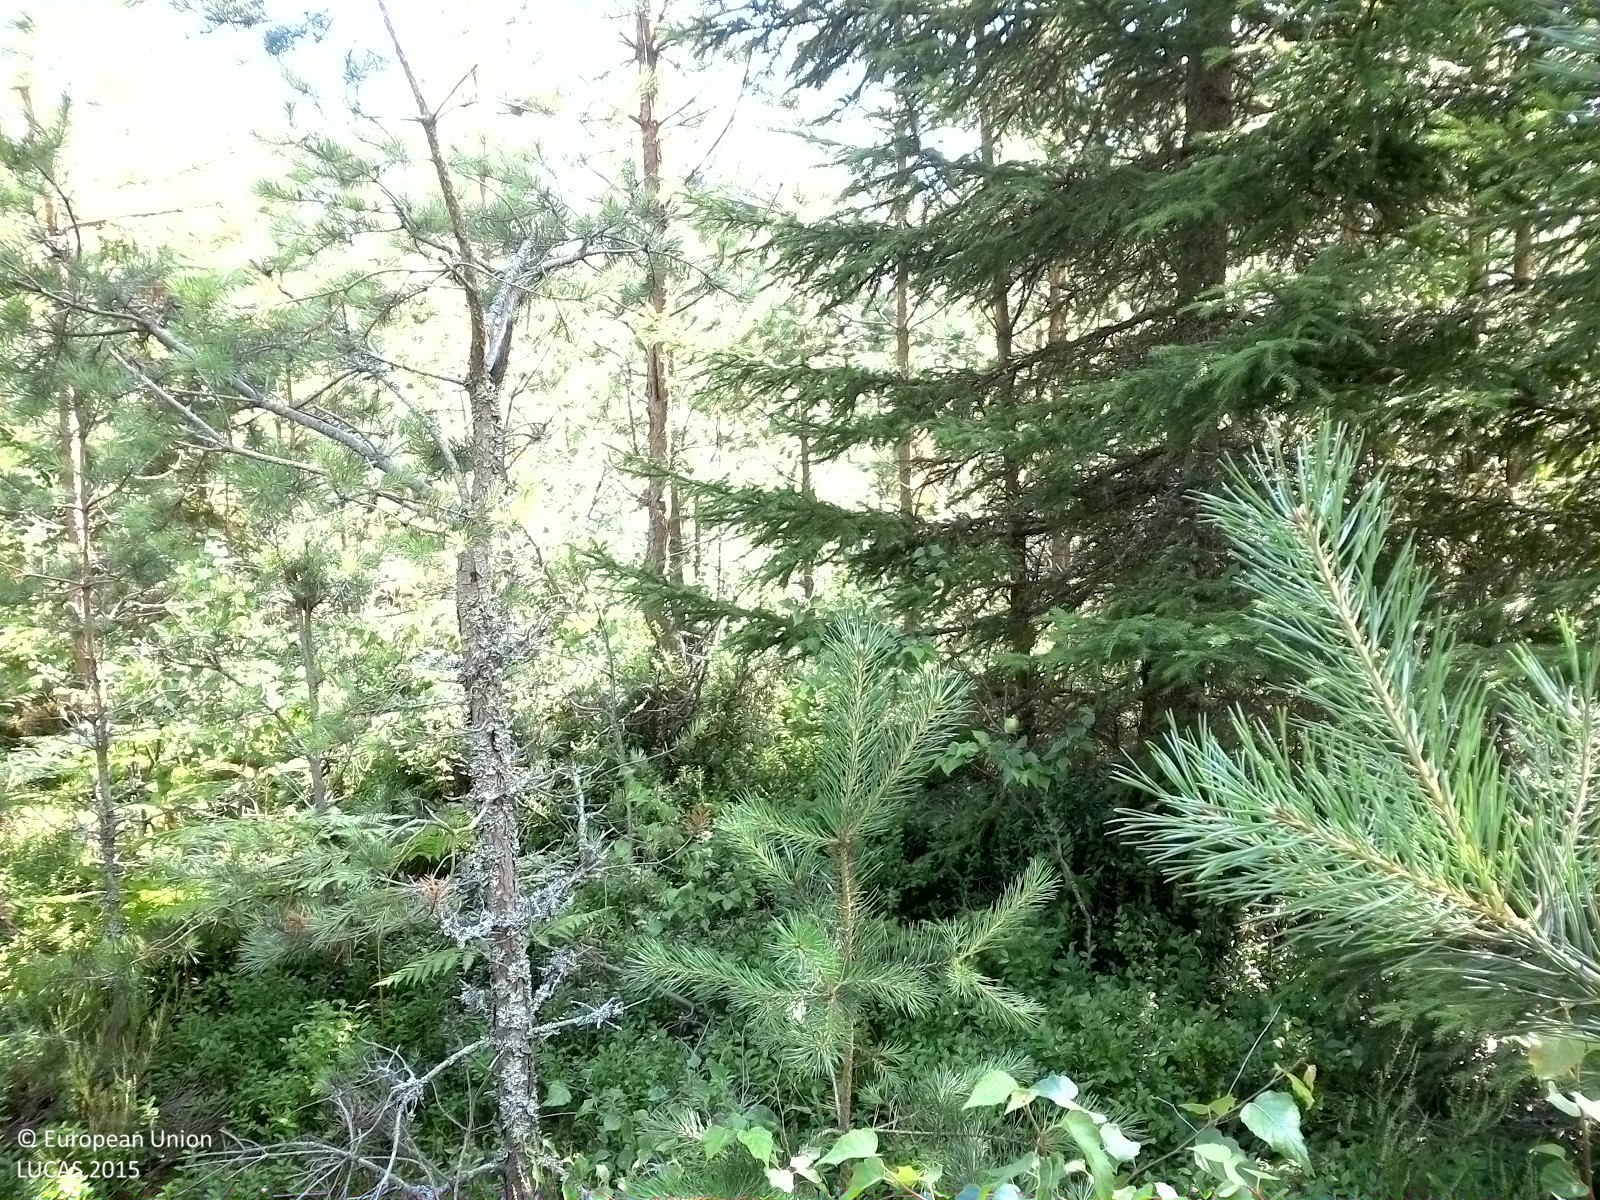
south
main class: Woodland
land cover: Pine dominated coniferous woodland
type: boreal forest
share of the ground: 50 - 75 %
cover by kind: coniferous forest trees 55 %, herbaceous plants 25 %, shrubs 15 %, lichens and mosses 5 %
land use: Forestry
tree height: < 5 m
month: August
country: SE
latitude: 58.9959
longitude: 15.3708
